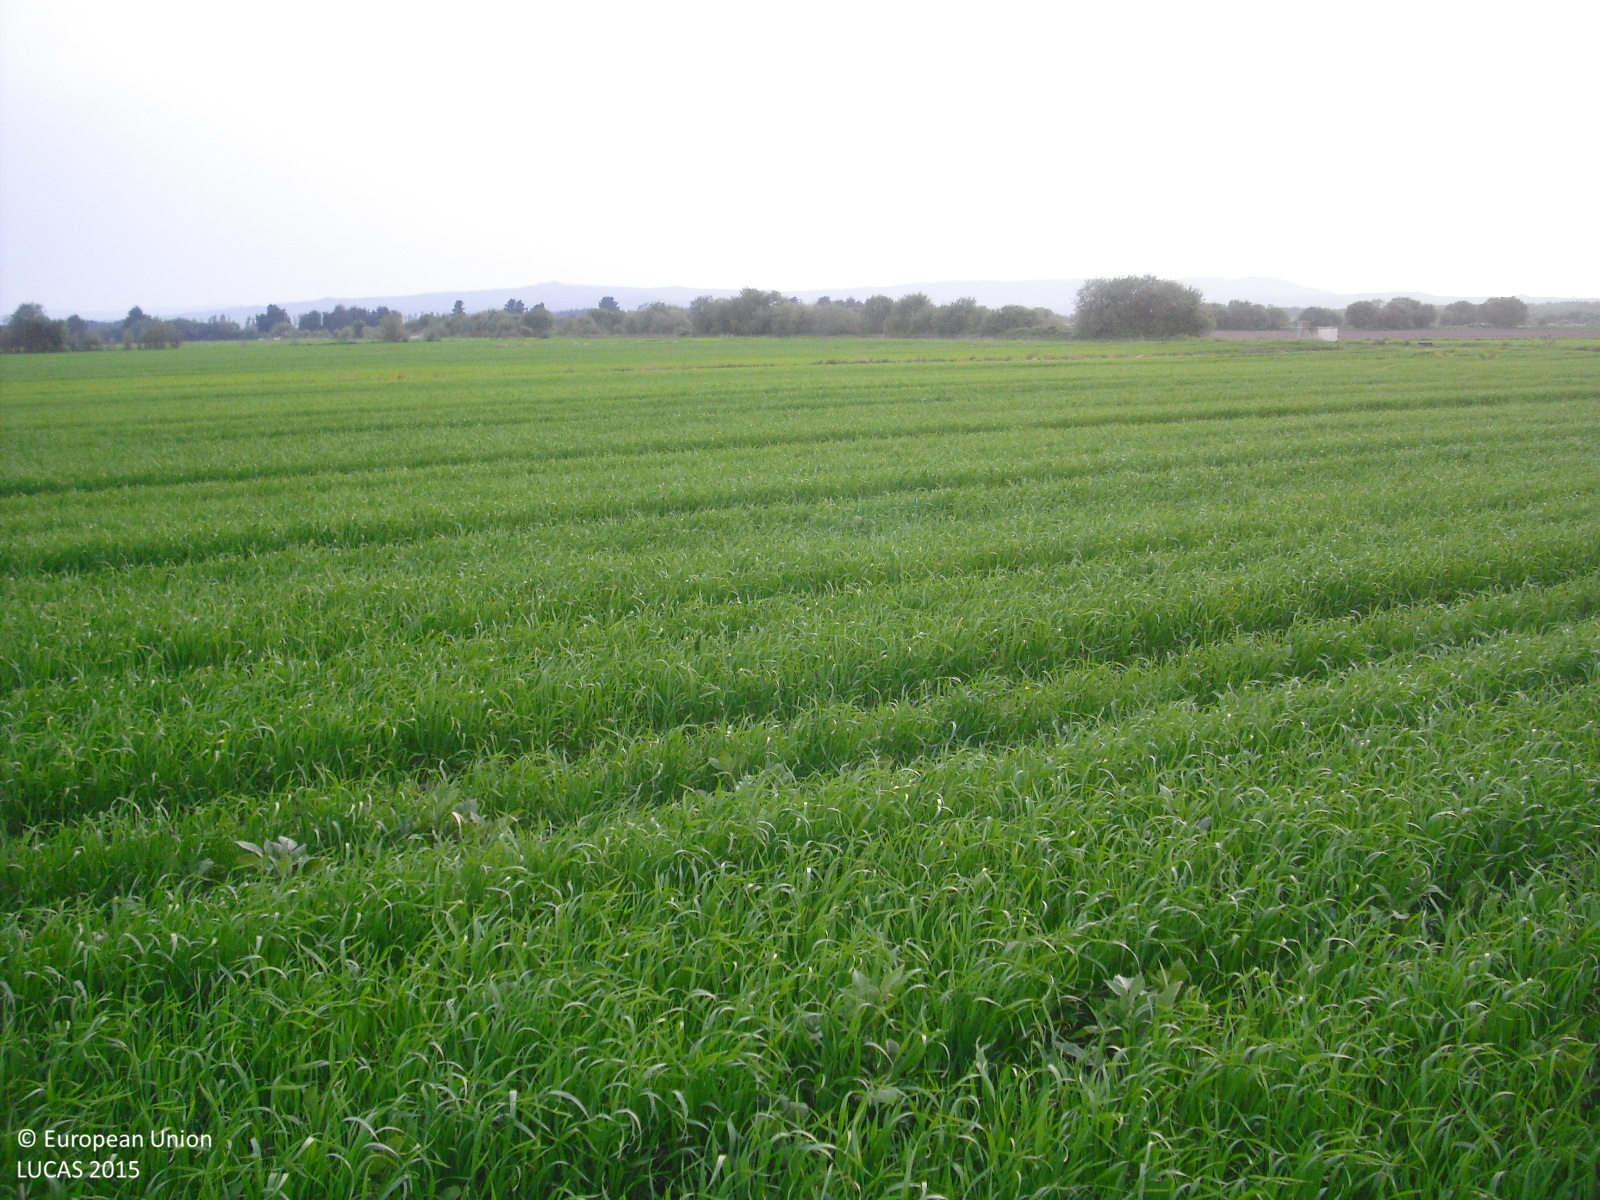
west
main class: Cropland
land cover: Common wheat
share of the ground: > 75 %
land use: Agriculture (excluding fallow land and kitchen gardens)
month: May
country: ES
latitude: 42.1367
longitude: -7.6726
